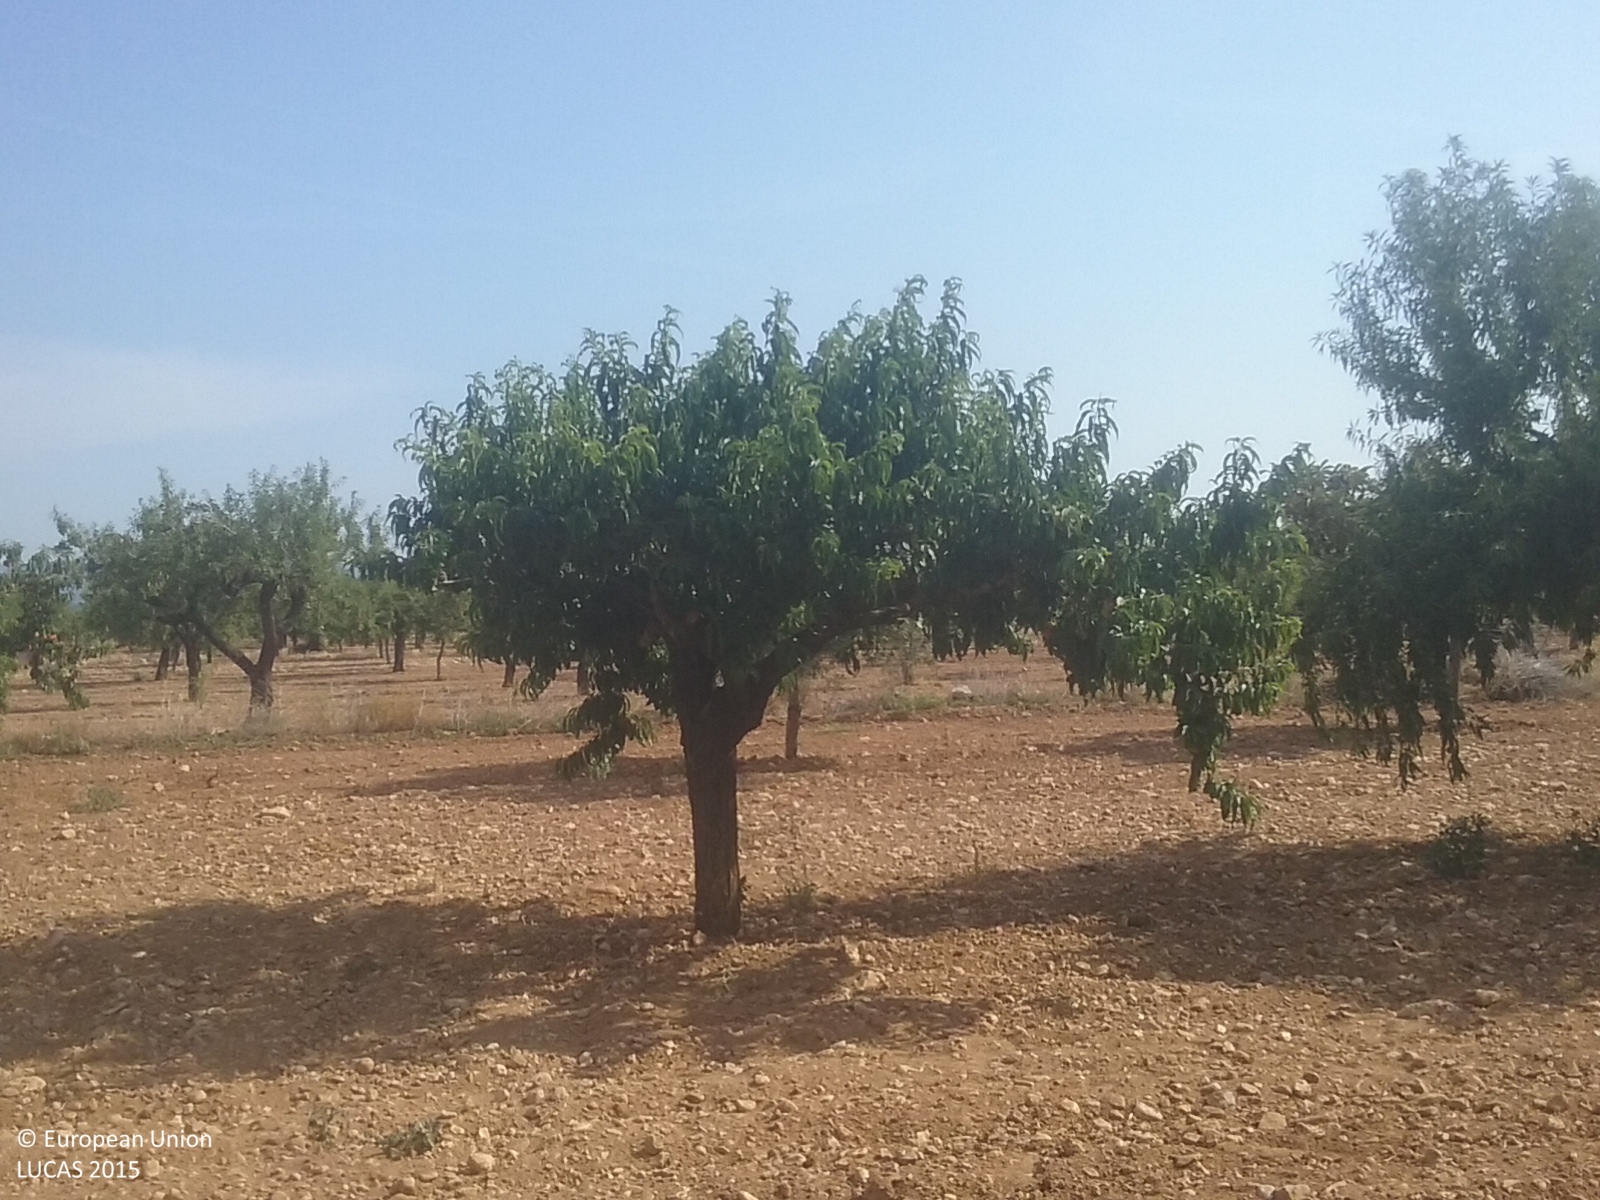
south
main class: Cropland
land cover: Nuts trees
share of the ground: 50 - 75 %
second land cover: Other bare soil
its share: > 75 %
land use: Agriculture (excluding fallow land and kitchen gardens)
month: July
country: ES
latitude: 40.2212
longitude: -0.0743
